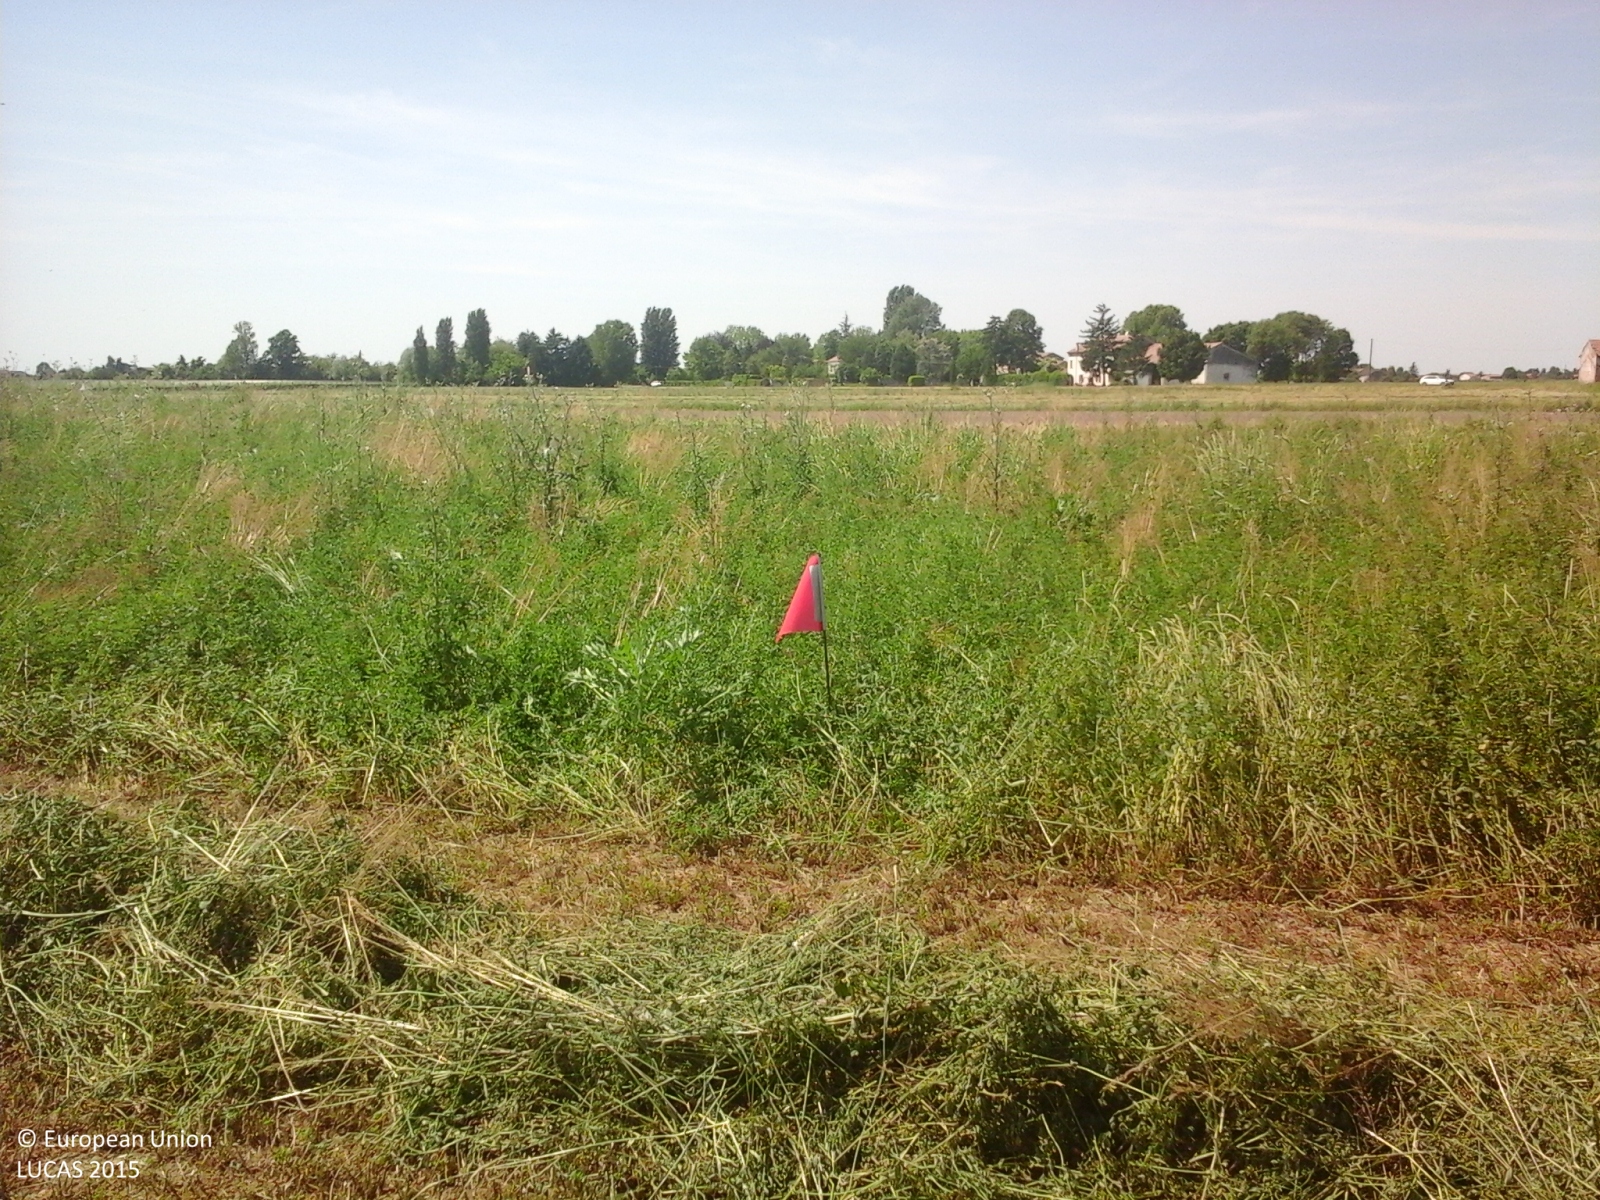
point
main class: Cropland
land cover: Lucerne
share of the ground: > 75 %
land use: Agriculture (excluding fallow land and kitchen gardens)
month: May
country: IT
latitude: 44.9759
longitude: 11.1011
